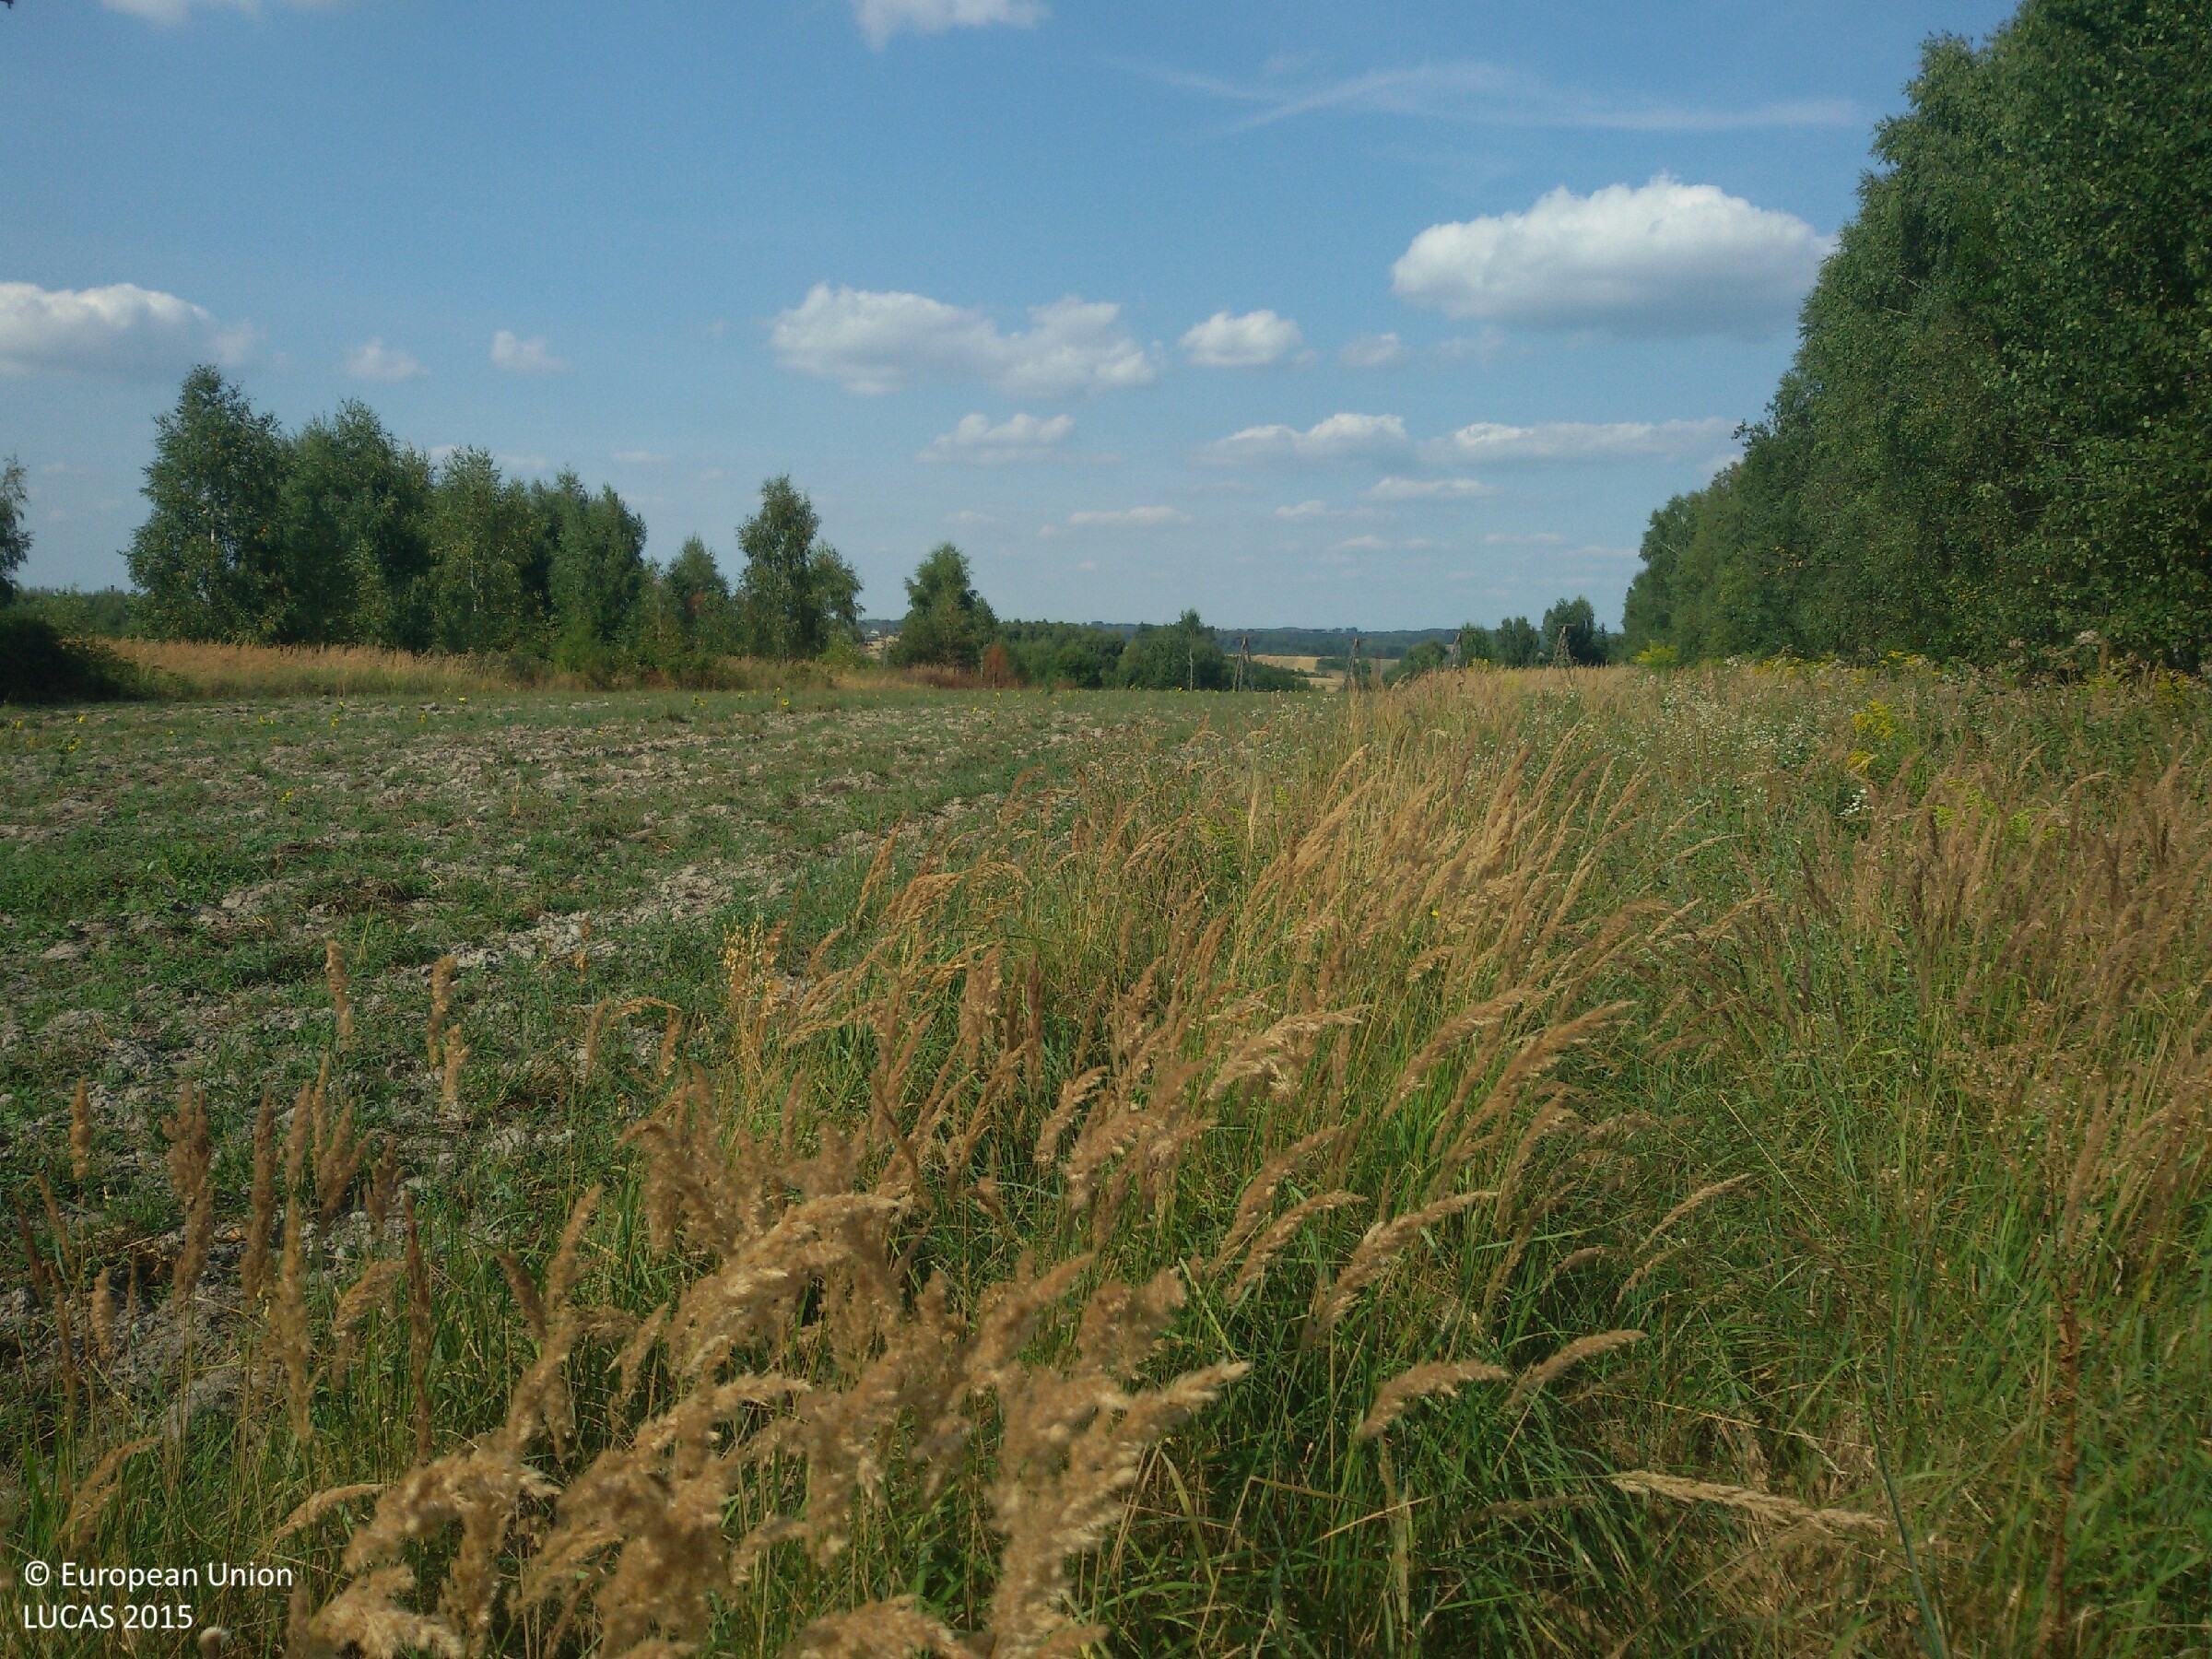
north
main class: Grassland
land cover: Spontaneously vegetated surfaces
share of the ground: > 75 %
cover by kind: herbaceous plants 100 %
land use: Fallow land
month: August
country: PL
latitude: 50.5984
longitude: 20.7642
